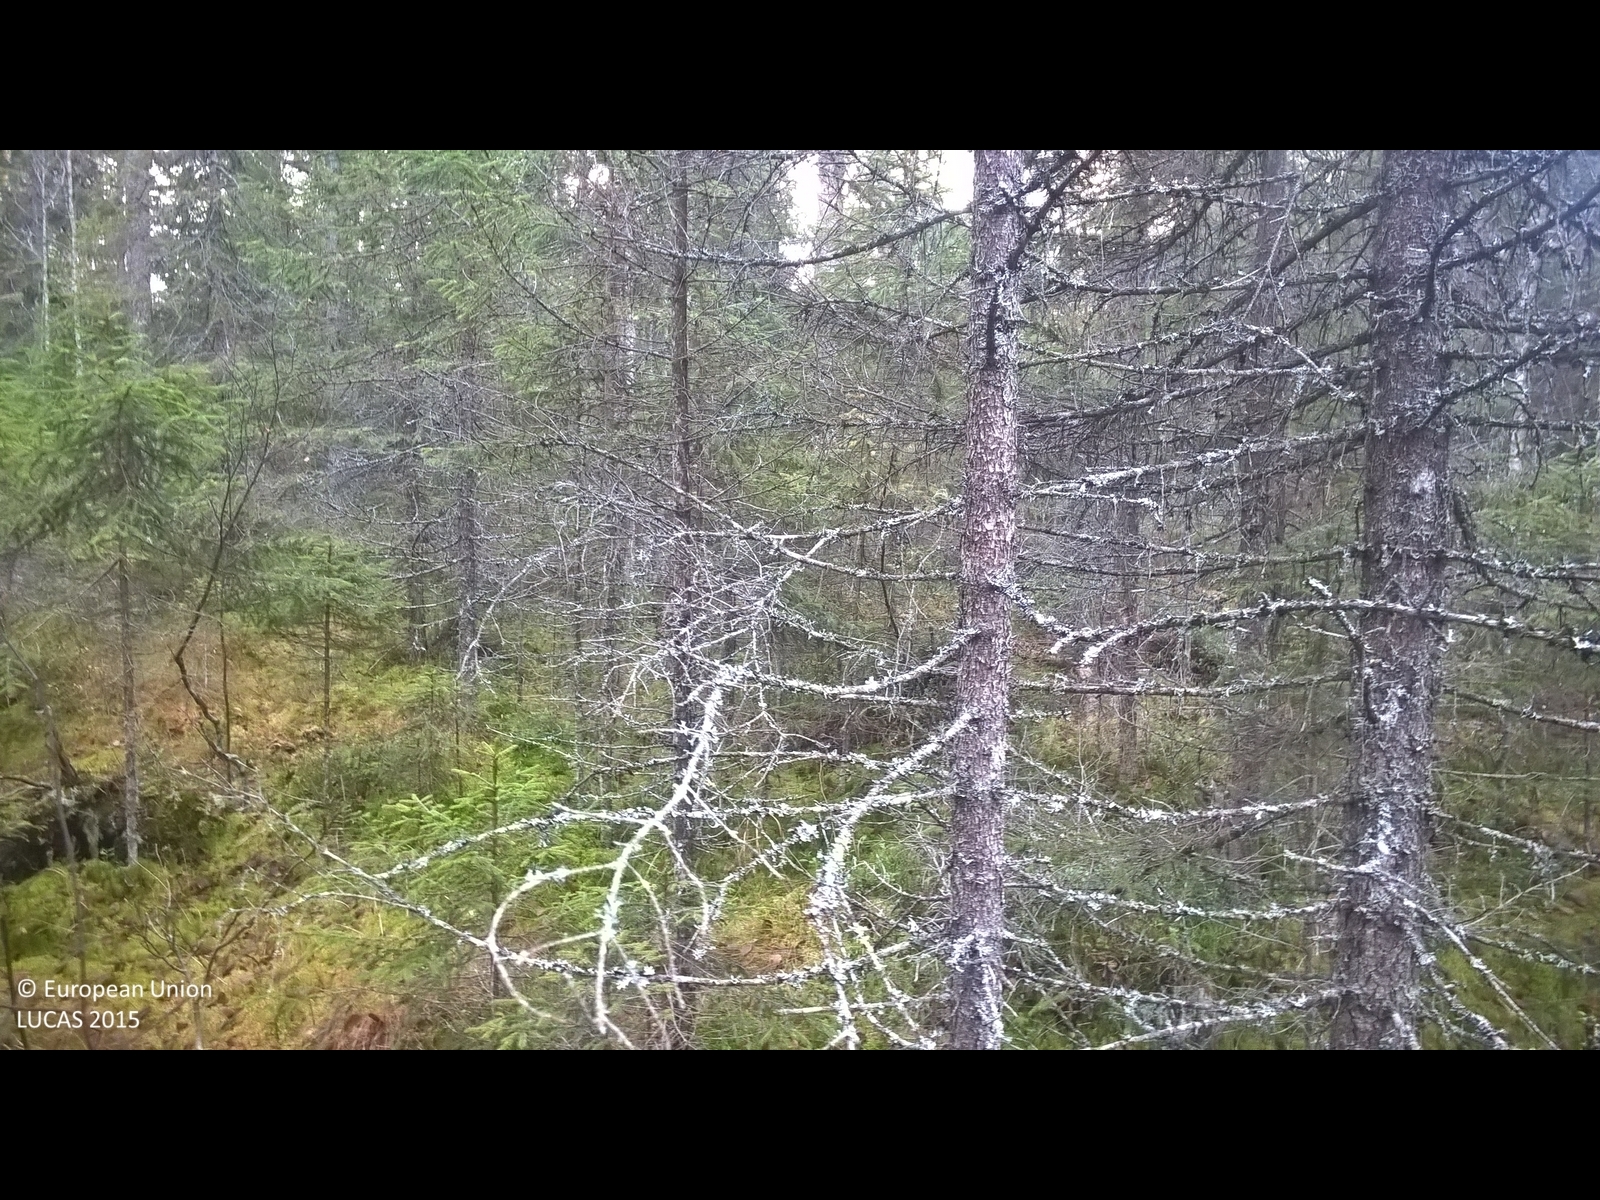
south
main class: Woodland
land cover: Spruce dominated coniferous woodland
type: boreal forest
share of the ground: > 75 %
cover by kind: coniferous forest trees 75 %, lichens and mosses 15 %, broadleaved forest trees 10 %
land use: Forestry
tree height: > 5 m
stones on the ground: < 10 %
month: November
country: SE
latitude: 62.7471
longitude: 14.9711
